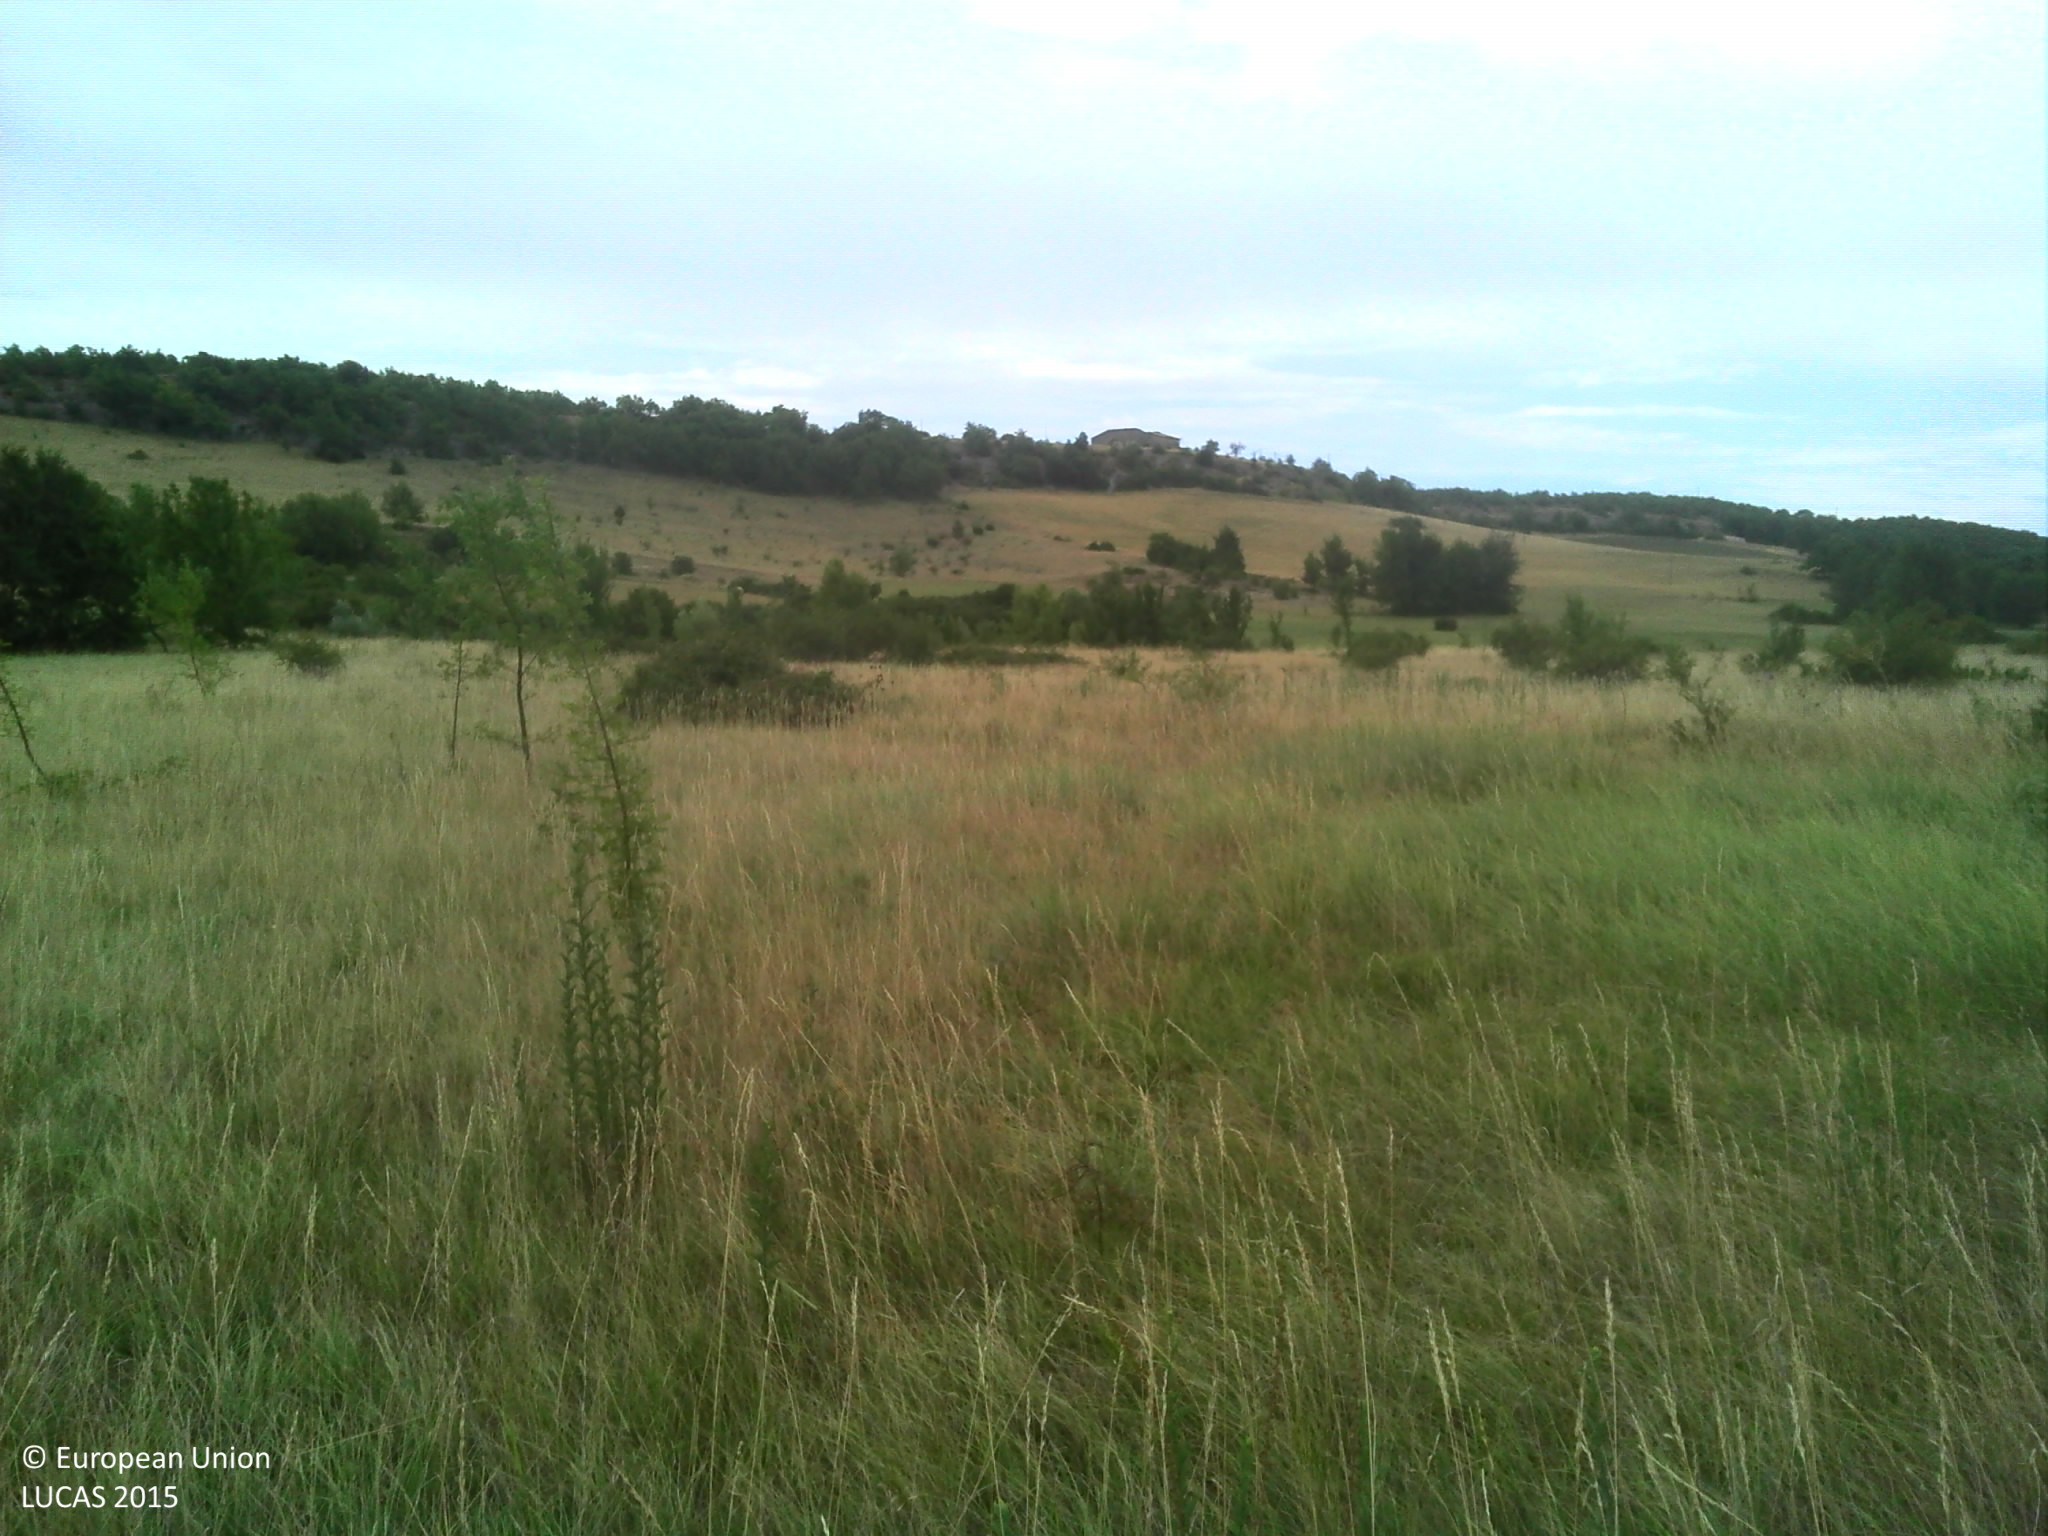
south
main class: Grassland
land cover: Grassland with sparse tree/shrub cover
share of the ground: > 75 %
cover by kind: herbaceous plants 95 %, broadleaved forest trees 5 %
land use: Semi-natural and natural areas not in use
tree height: < 5 m
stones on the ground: < 10 %
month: July
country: FR
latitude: 43.9856
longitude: 5.5822
